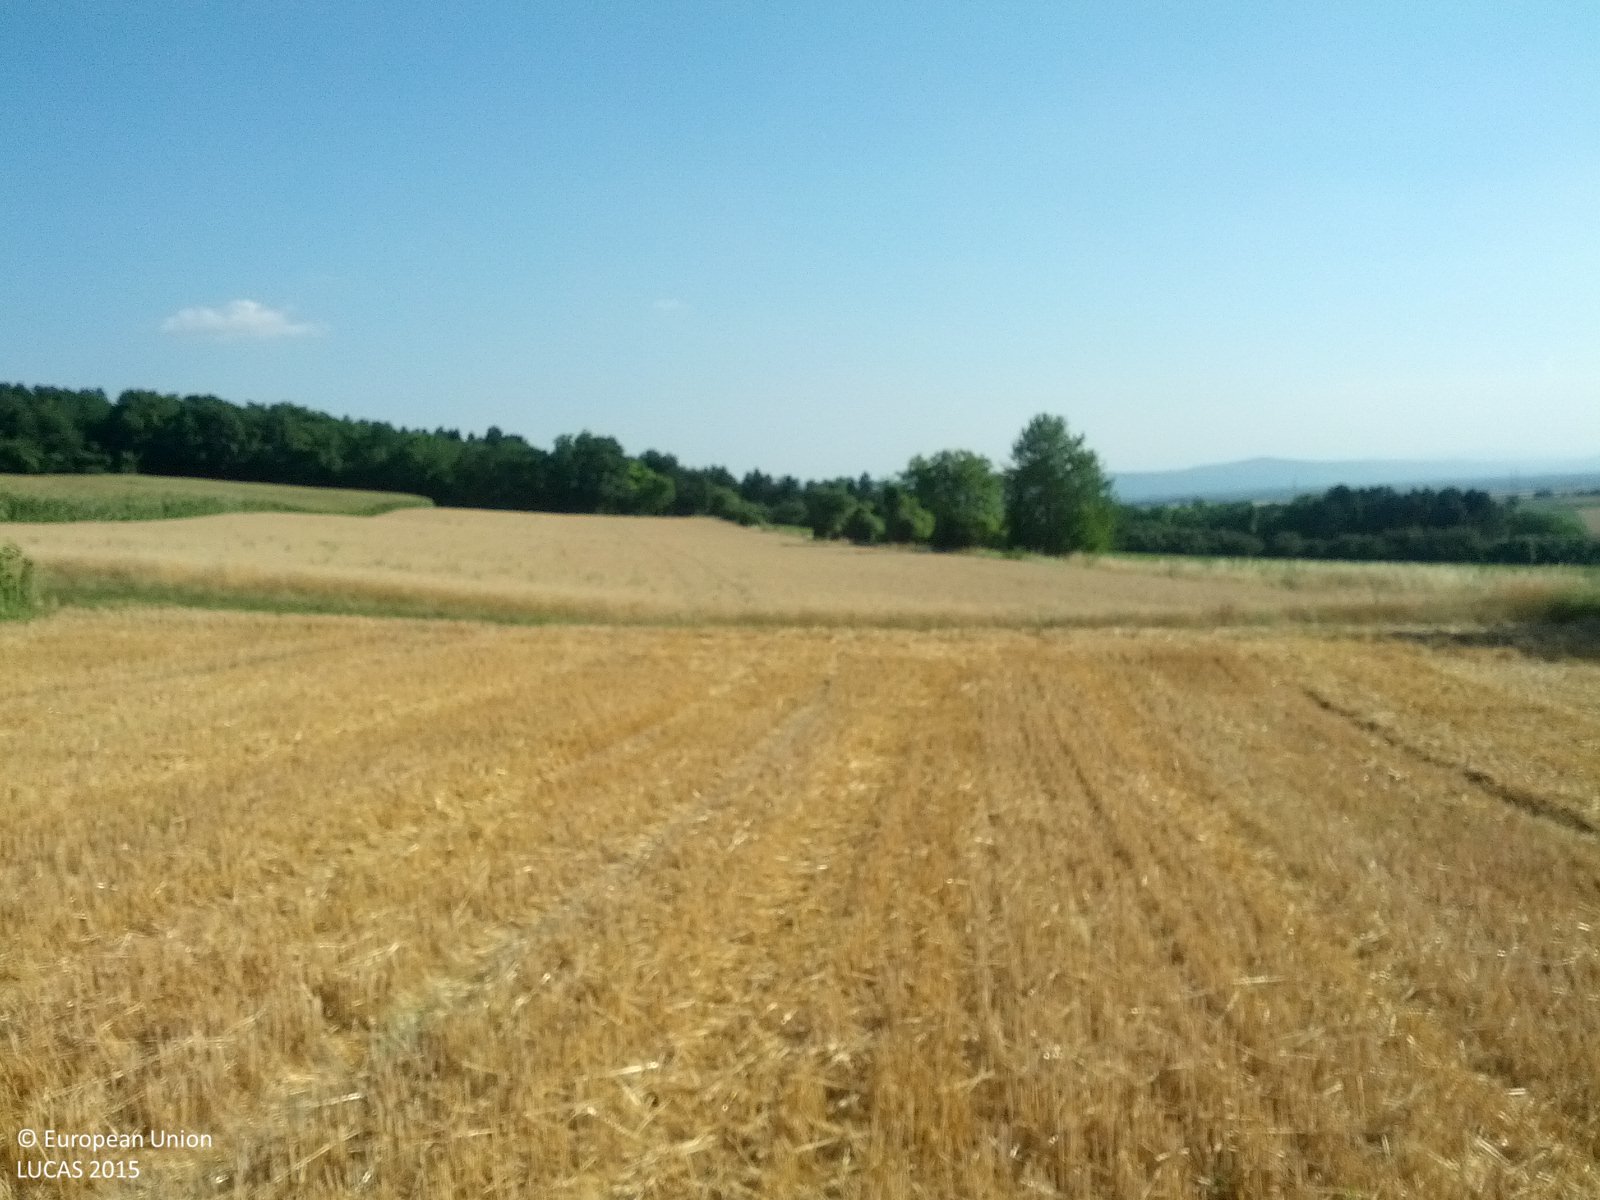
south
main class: Cropland
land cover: Common wheat
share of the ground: 10 - 25 %
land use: Agriculture (excluding fallow land and kitchen gardens)
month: July
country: AT
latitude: 48.4245
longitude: 16.2618
